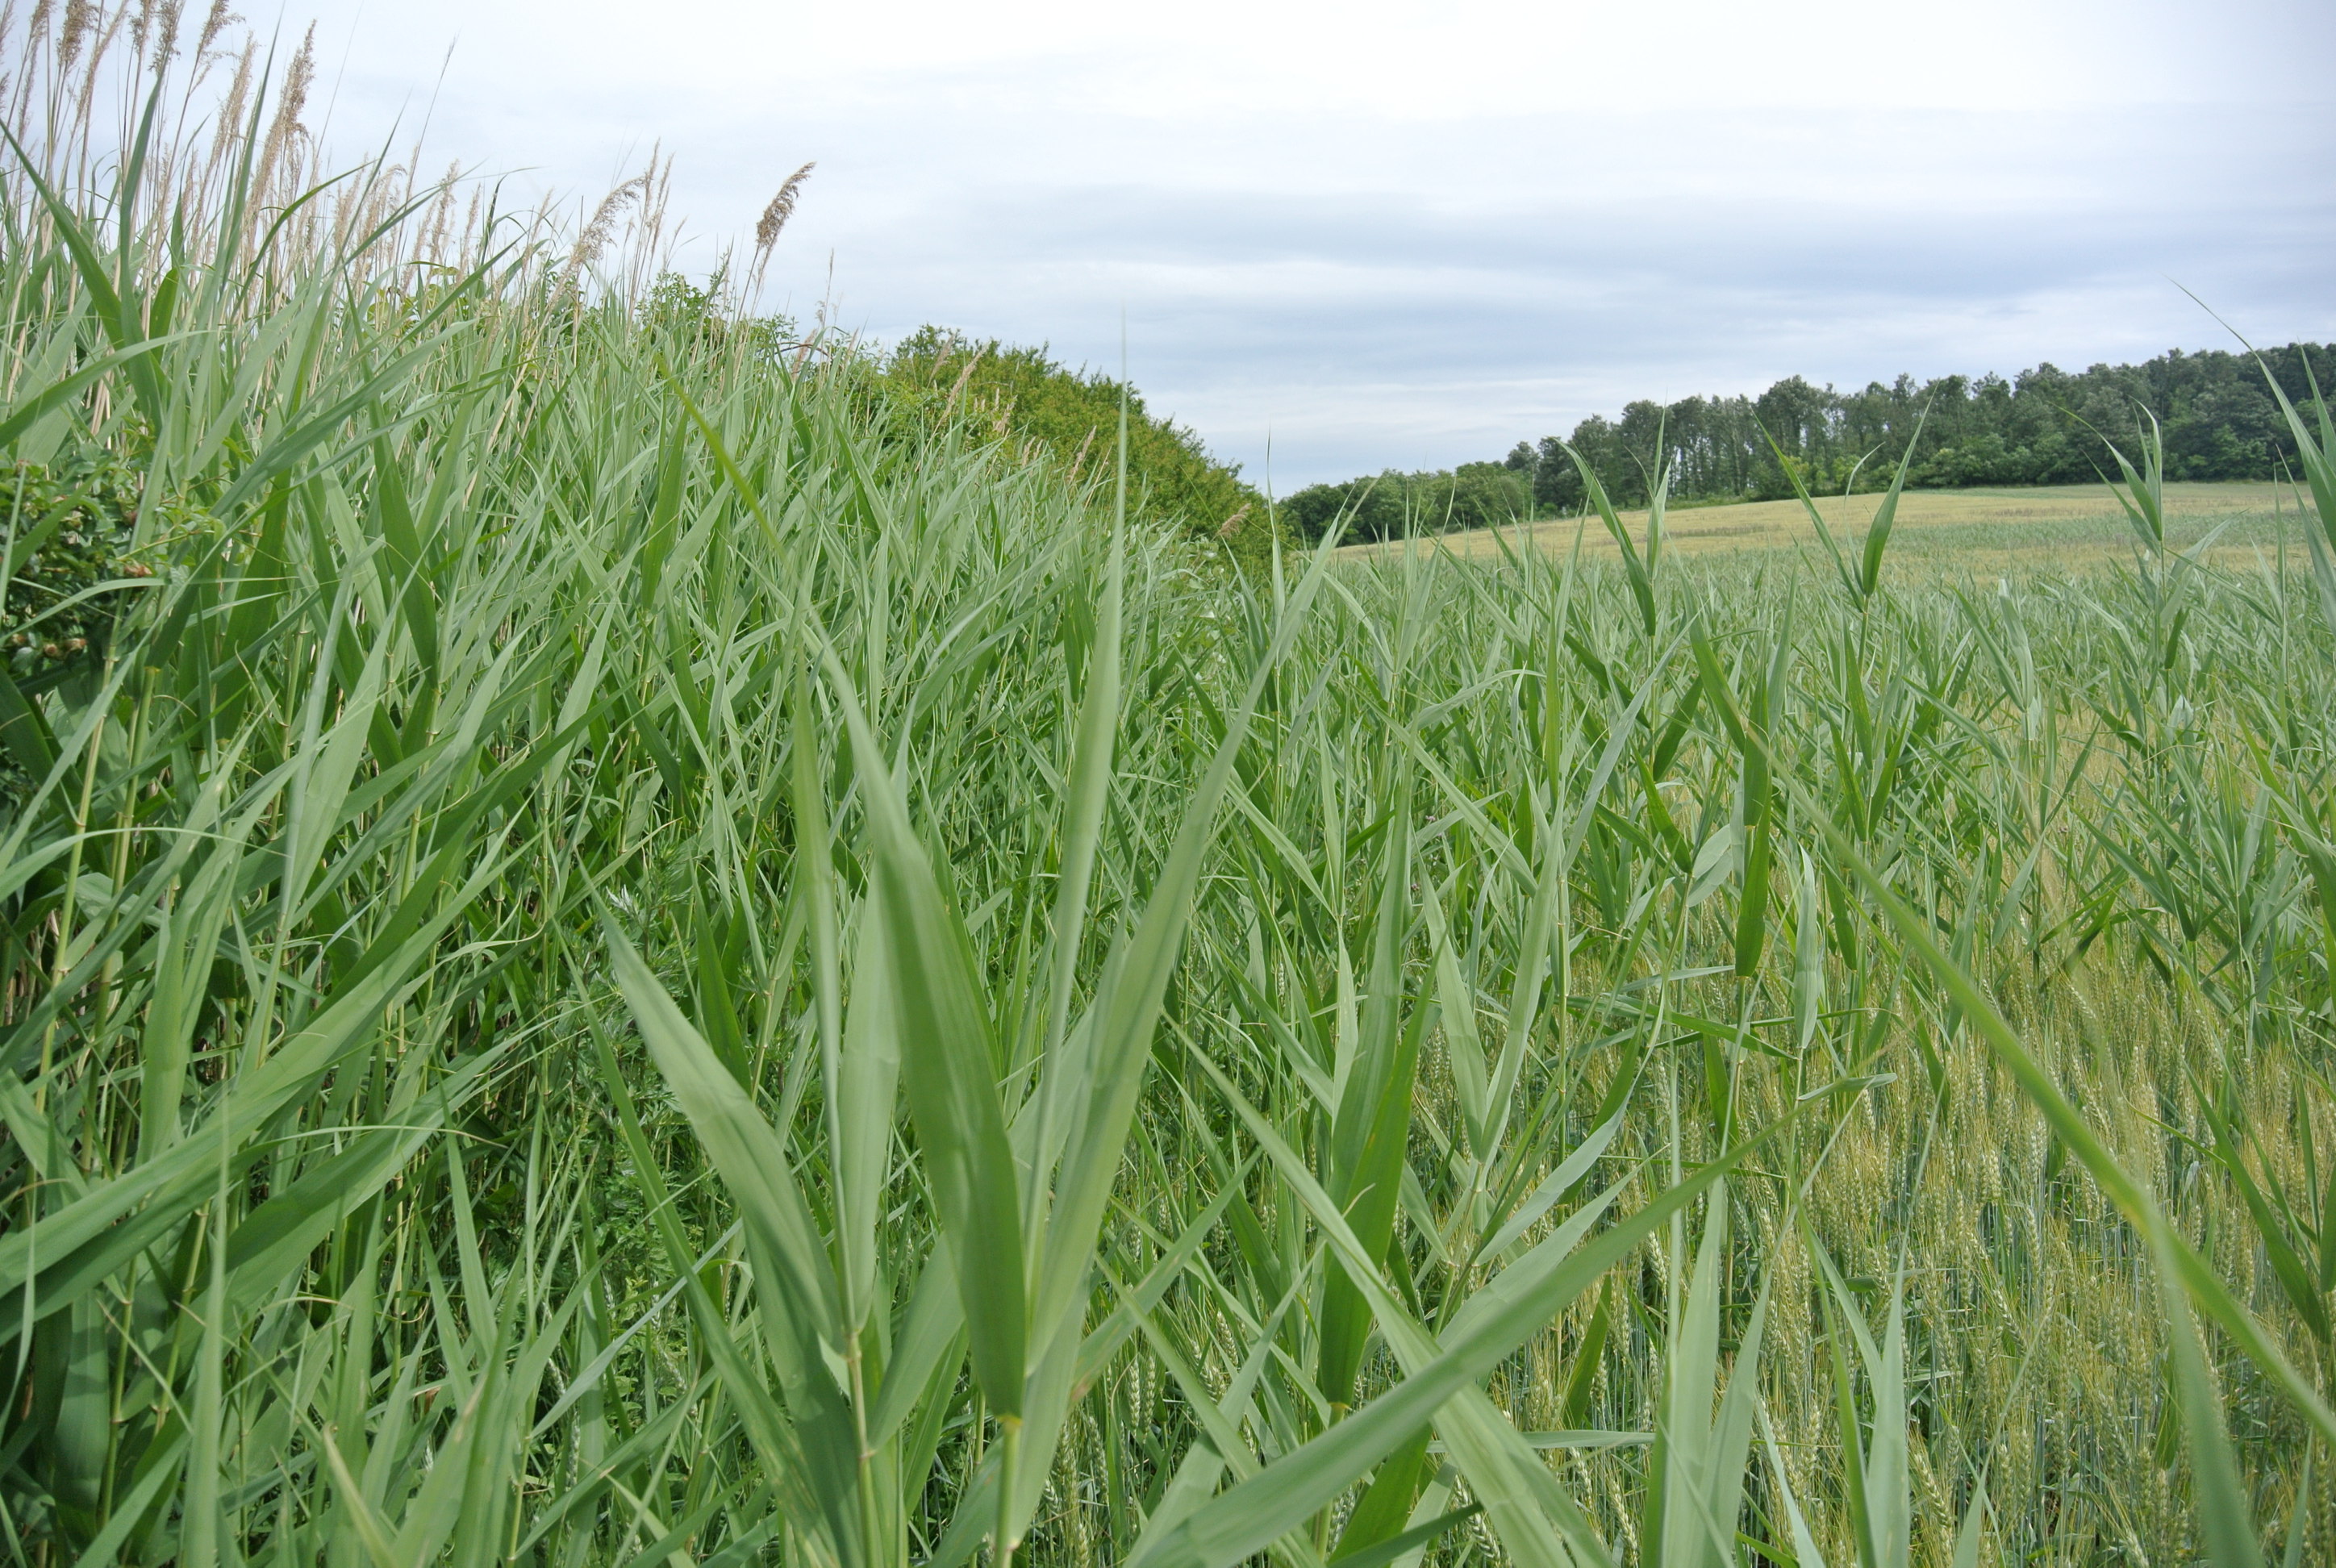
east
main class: Cropland
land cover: Common wheat
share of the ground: > 75 %
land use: Agriculture (excluding fallow land and kitchen gardens)
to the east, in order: Common wheat; Inland marshes; Rivers and streams; Shruby margins; Tracks; Grassland without tree/shrub cover; Vineyards; Grassland without tree/shrub cover; Temporary grasslands; Vineyards
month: June
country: AT
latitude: 47.7592
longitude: 16.5282
